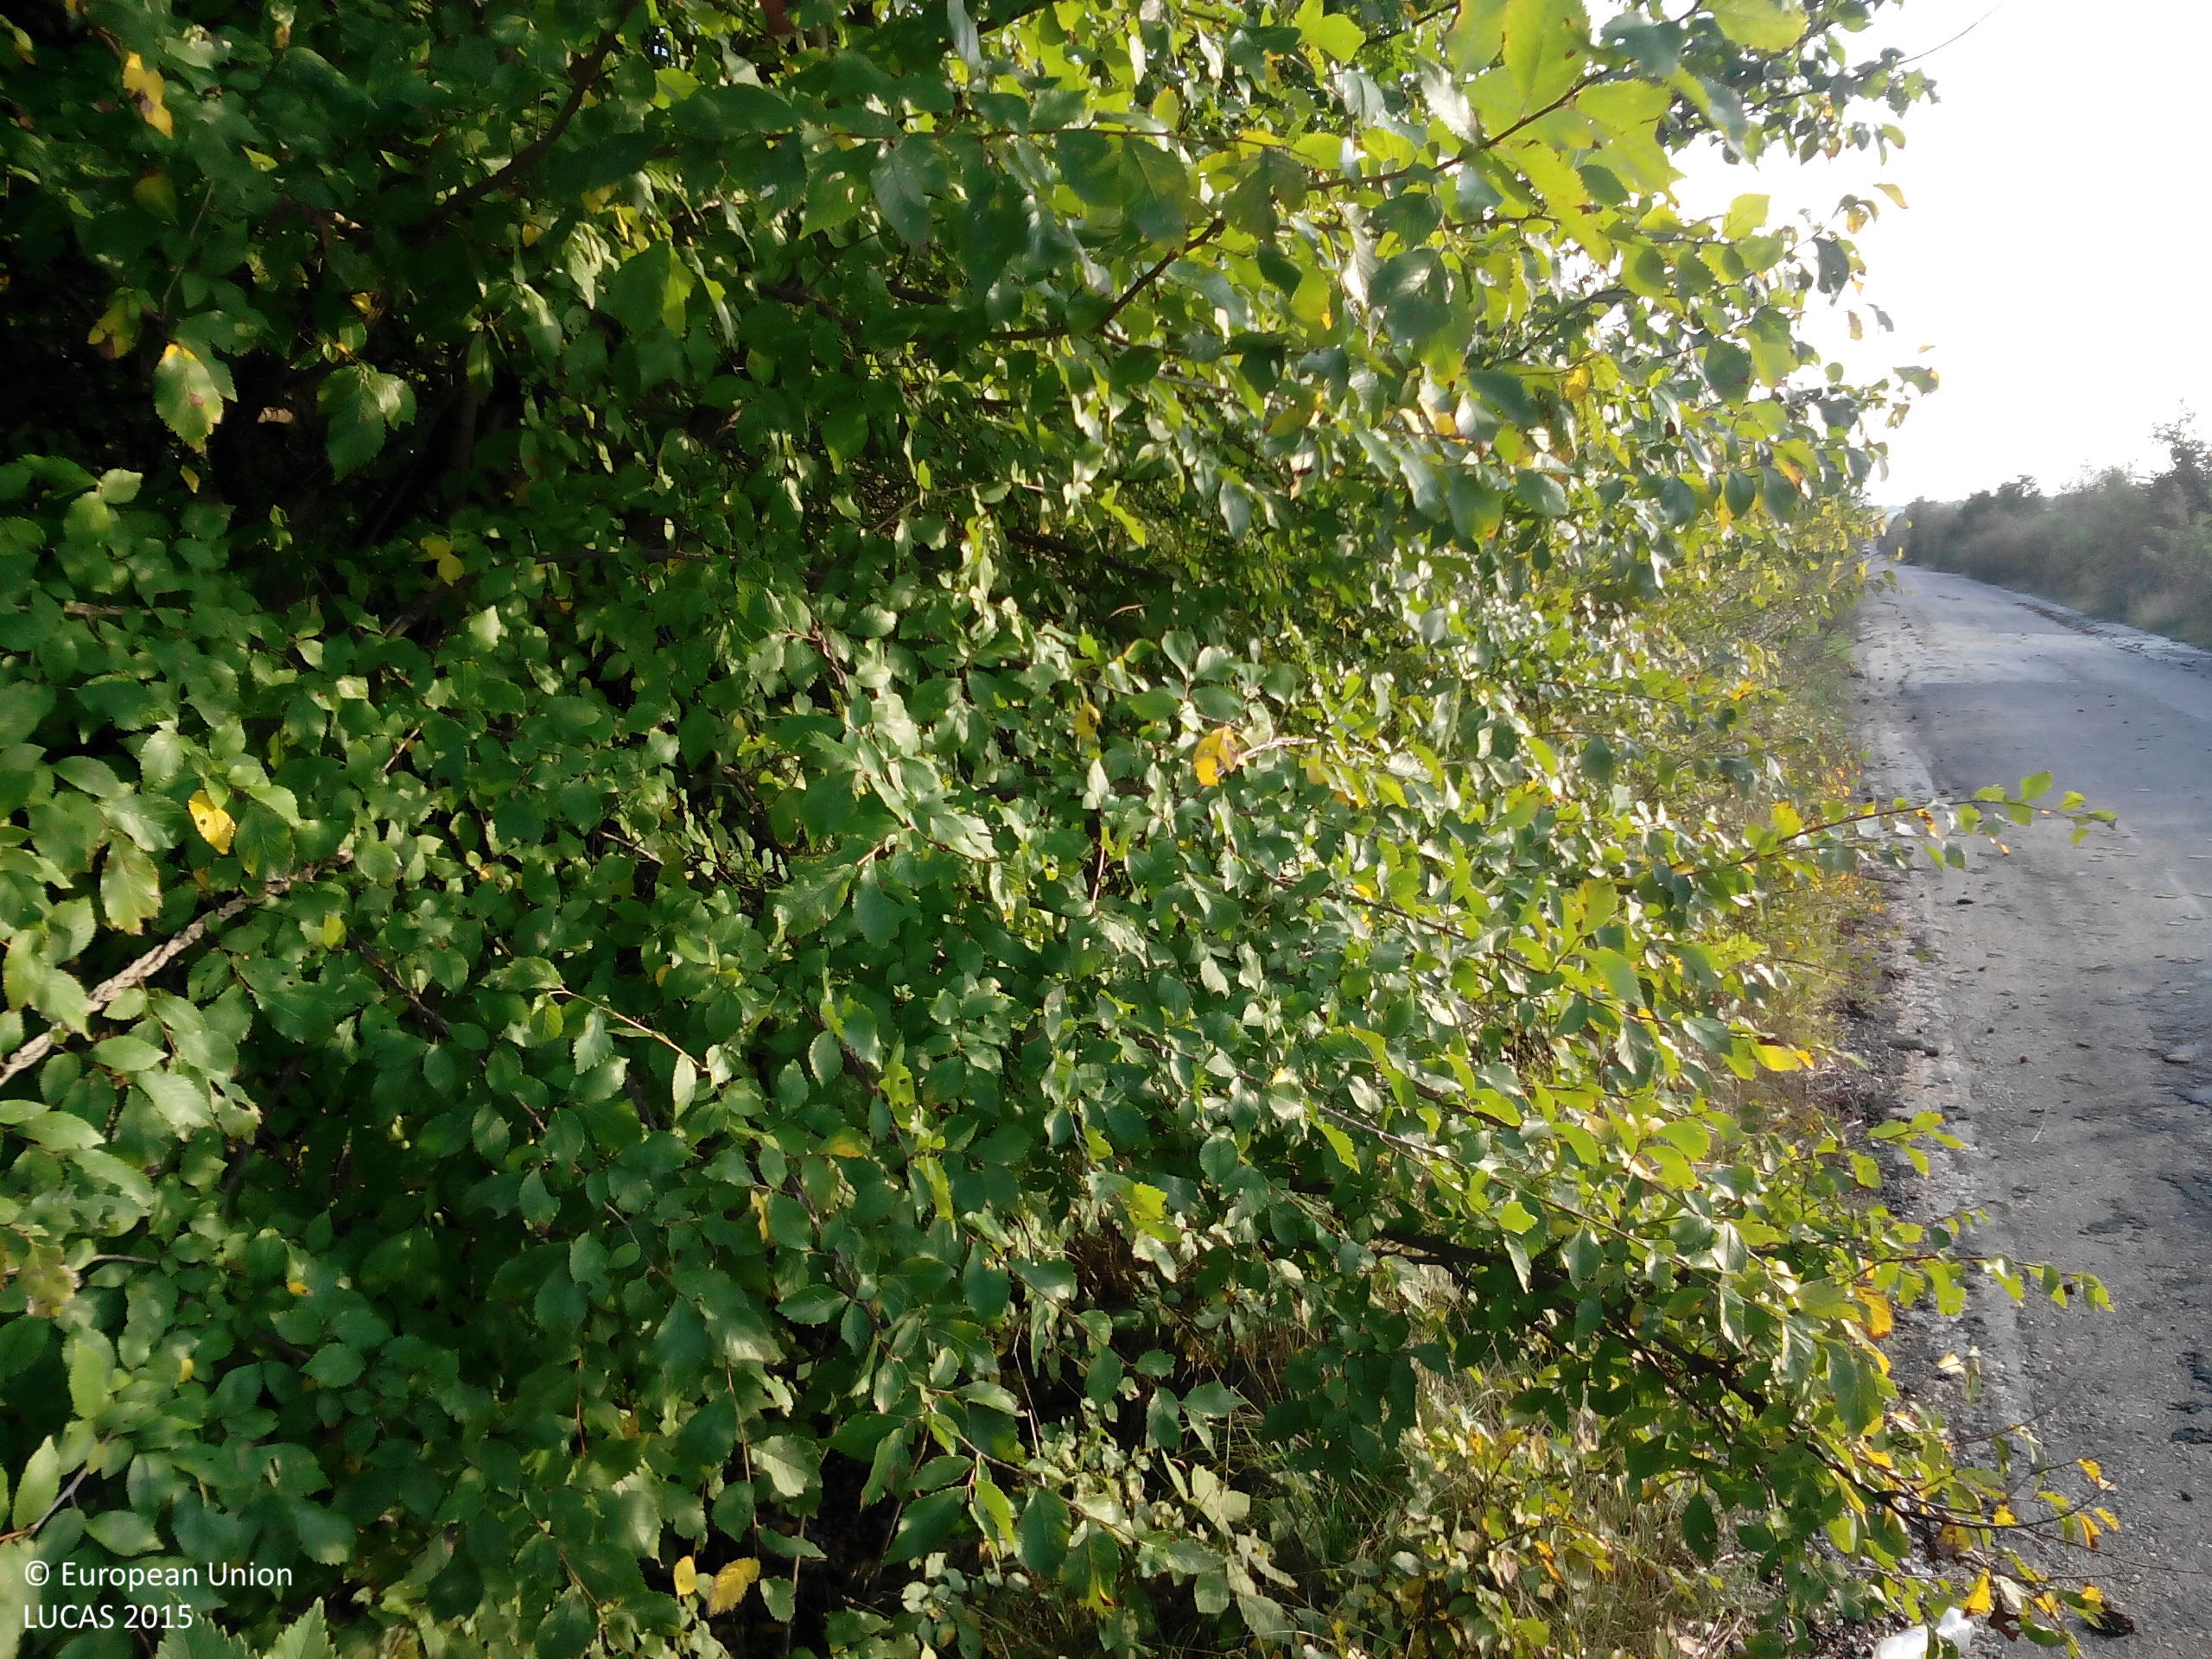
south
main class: Woodland
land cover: Broadleaved woodland
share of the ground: > 75 %
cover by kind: broadleaved forest trees 80 %, shrubs 20 %
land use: Road transport
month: October
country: BG
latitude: 43.2801
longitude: 23.9124
